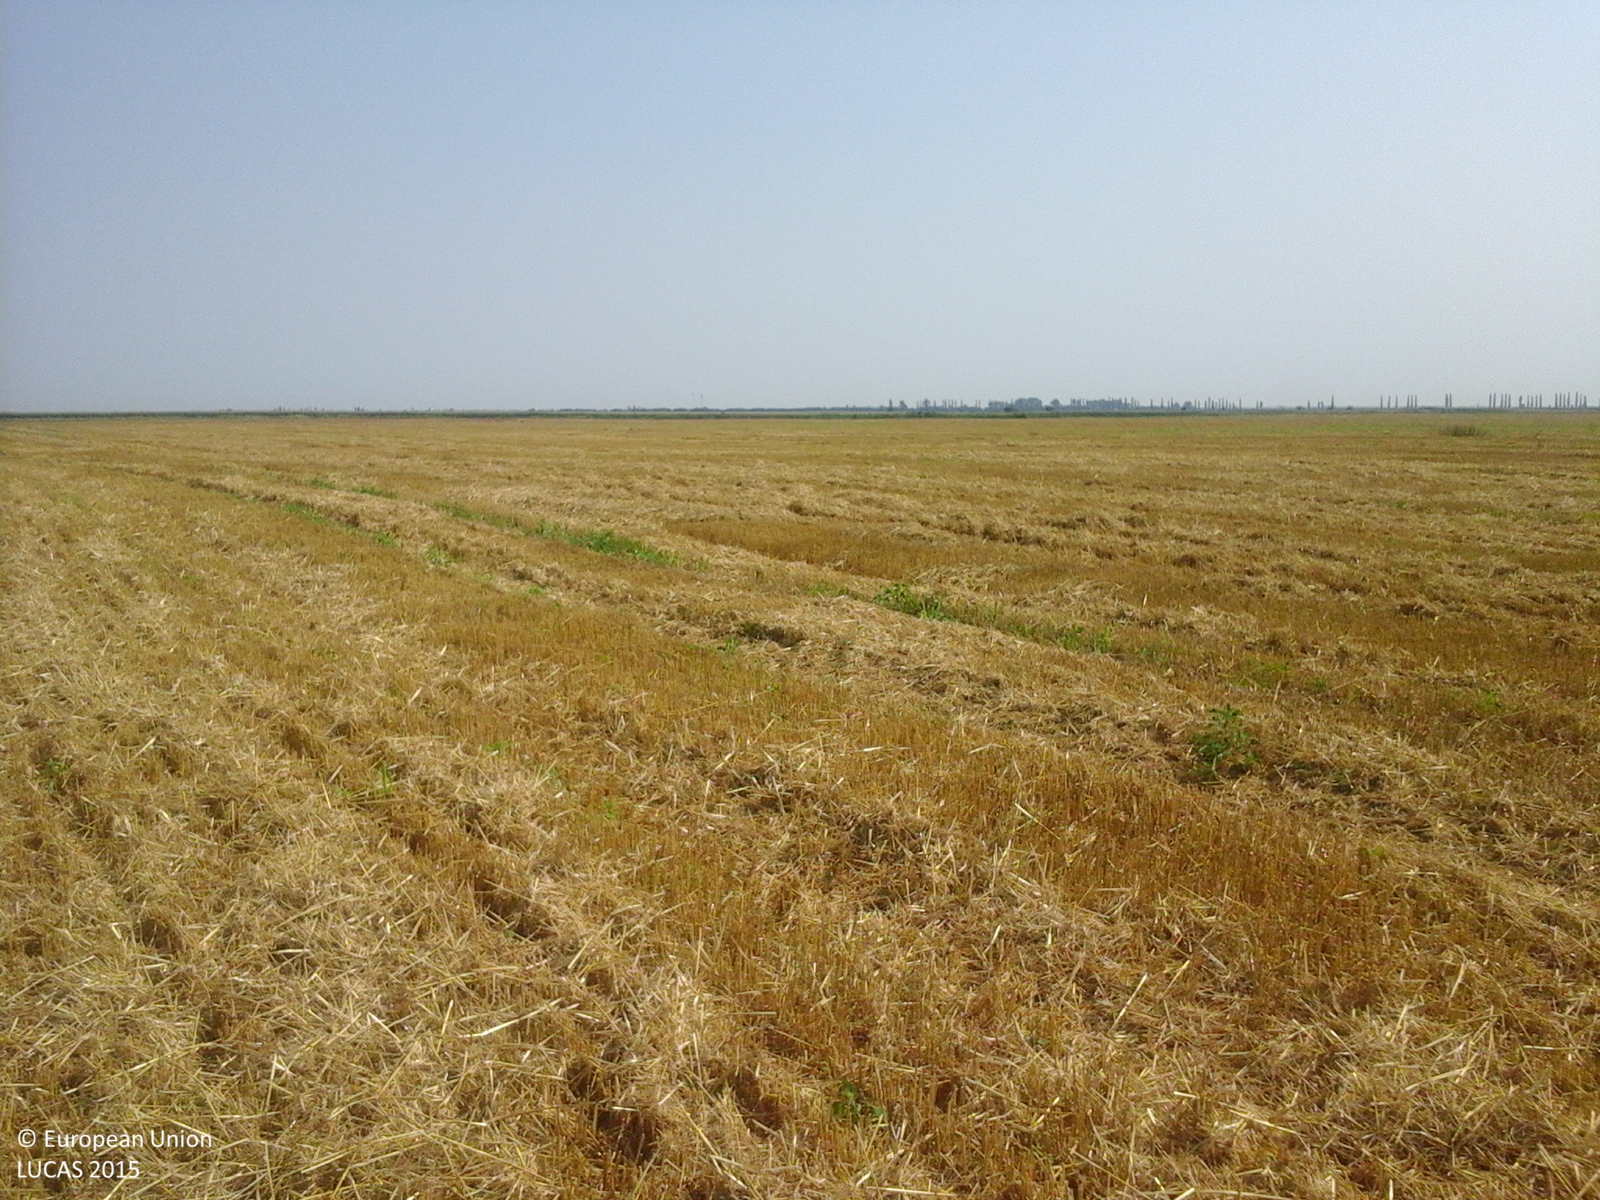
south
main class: Cropland
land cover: Common wheat
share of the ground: < 10 %
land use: Agriculture (excluding fallow land and kitchen gardens)
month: July
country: RO
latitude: 44.8639
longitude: 26.7950
